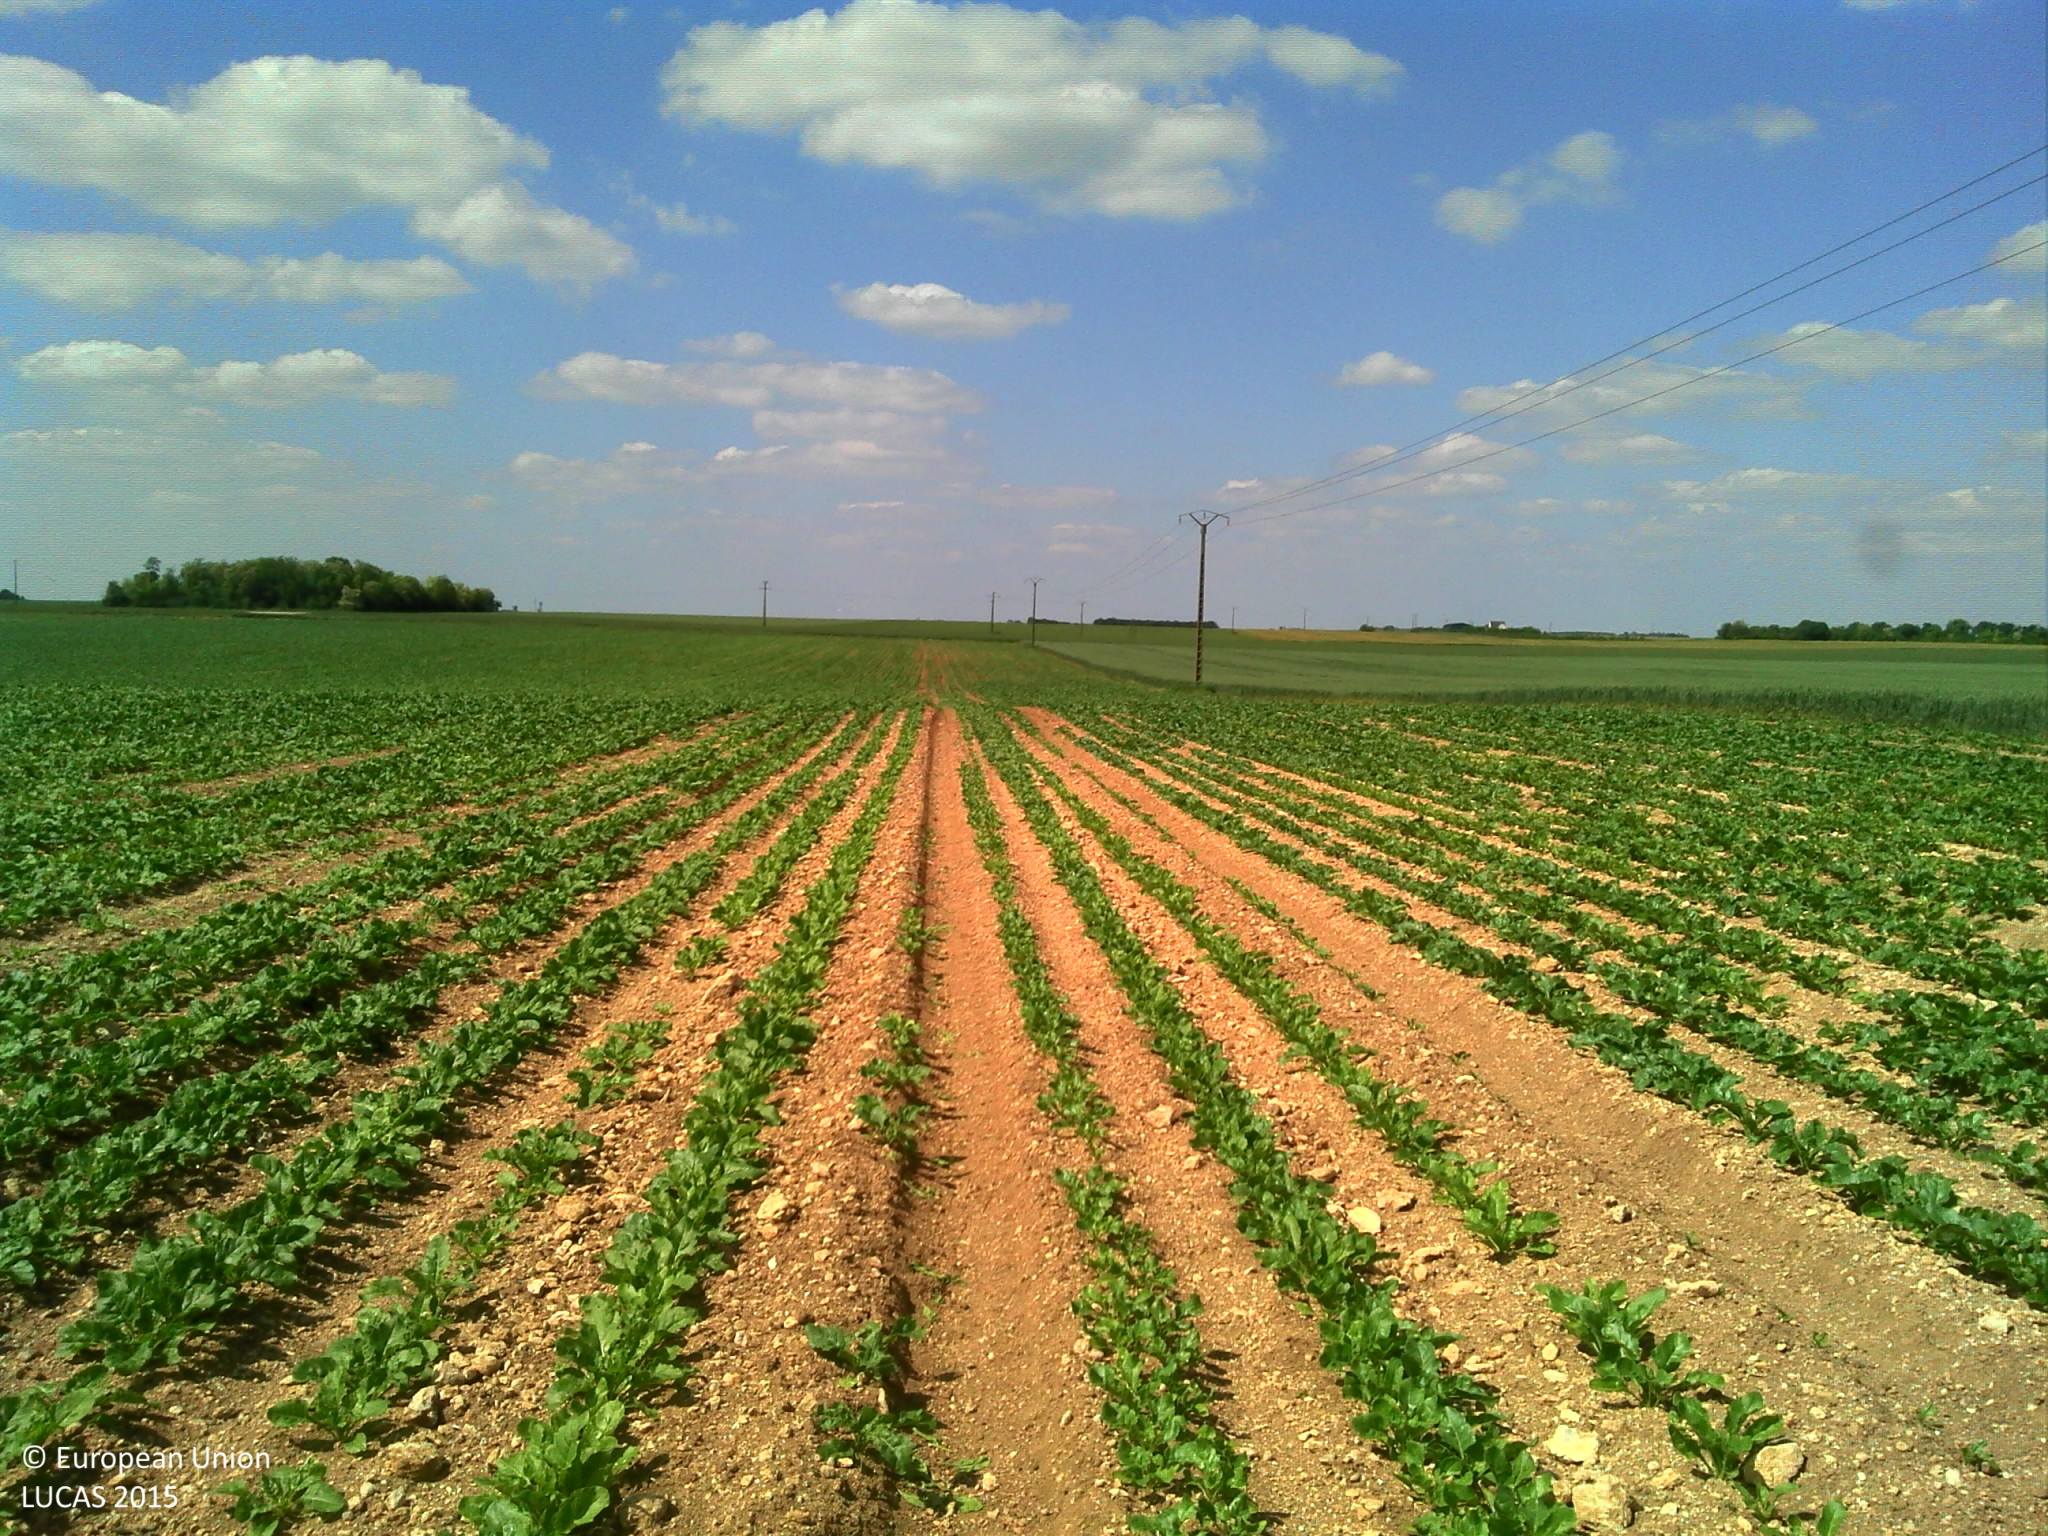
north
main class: Cropland
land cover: Sugar beet
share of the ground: 10 - 25 %
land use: Agriculture (excluding fallow land and kitchen gardens)
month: May
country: FR
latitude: 48.2699
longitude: 1.9162
